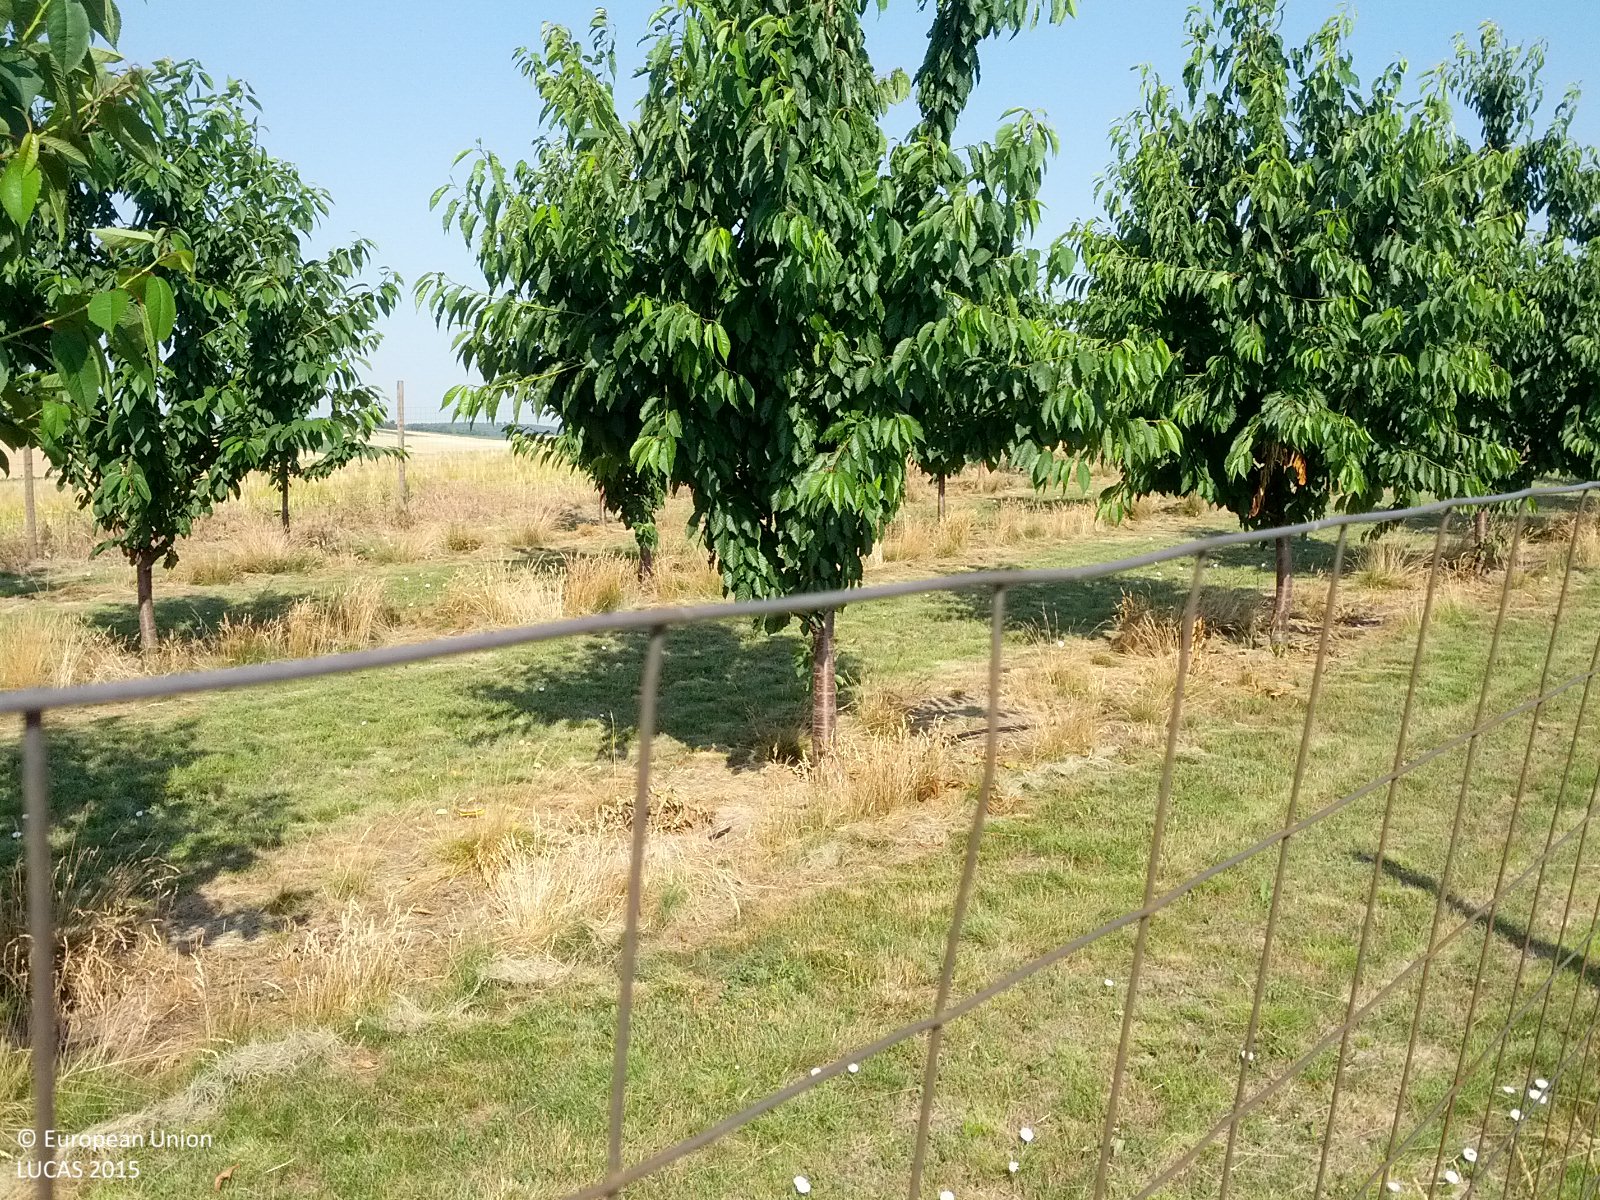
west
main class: Cropland
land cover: Cherry fruit
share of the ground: 25 - 50 %
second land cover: Grassland without tree/shrub cover
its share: 50 - 75 %
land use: Agriculture (excluding fallow land and kitchen gardens)
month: July
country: AT
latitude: 48.6011
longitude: 16.6379
